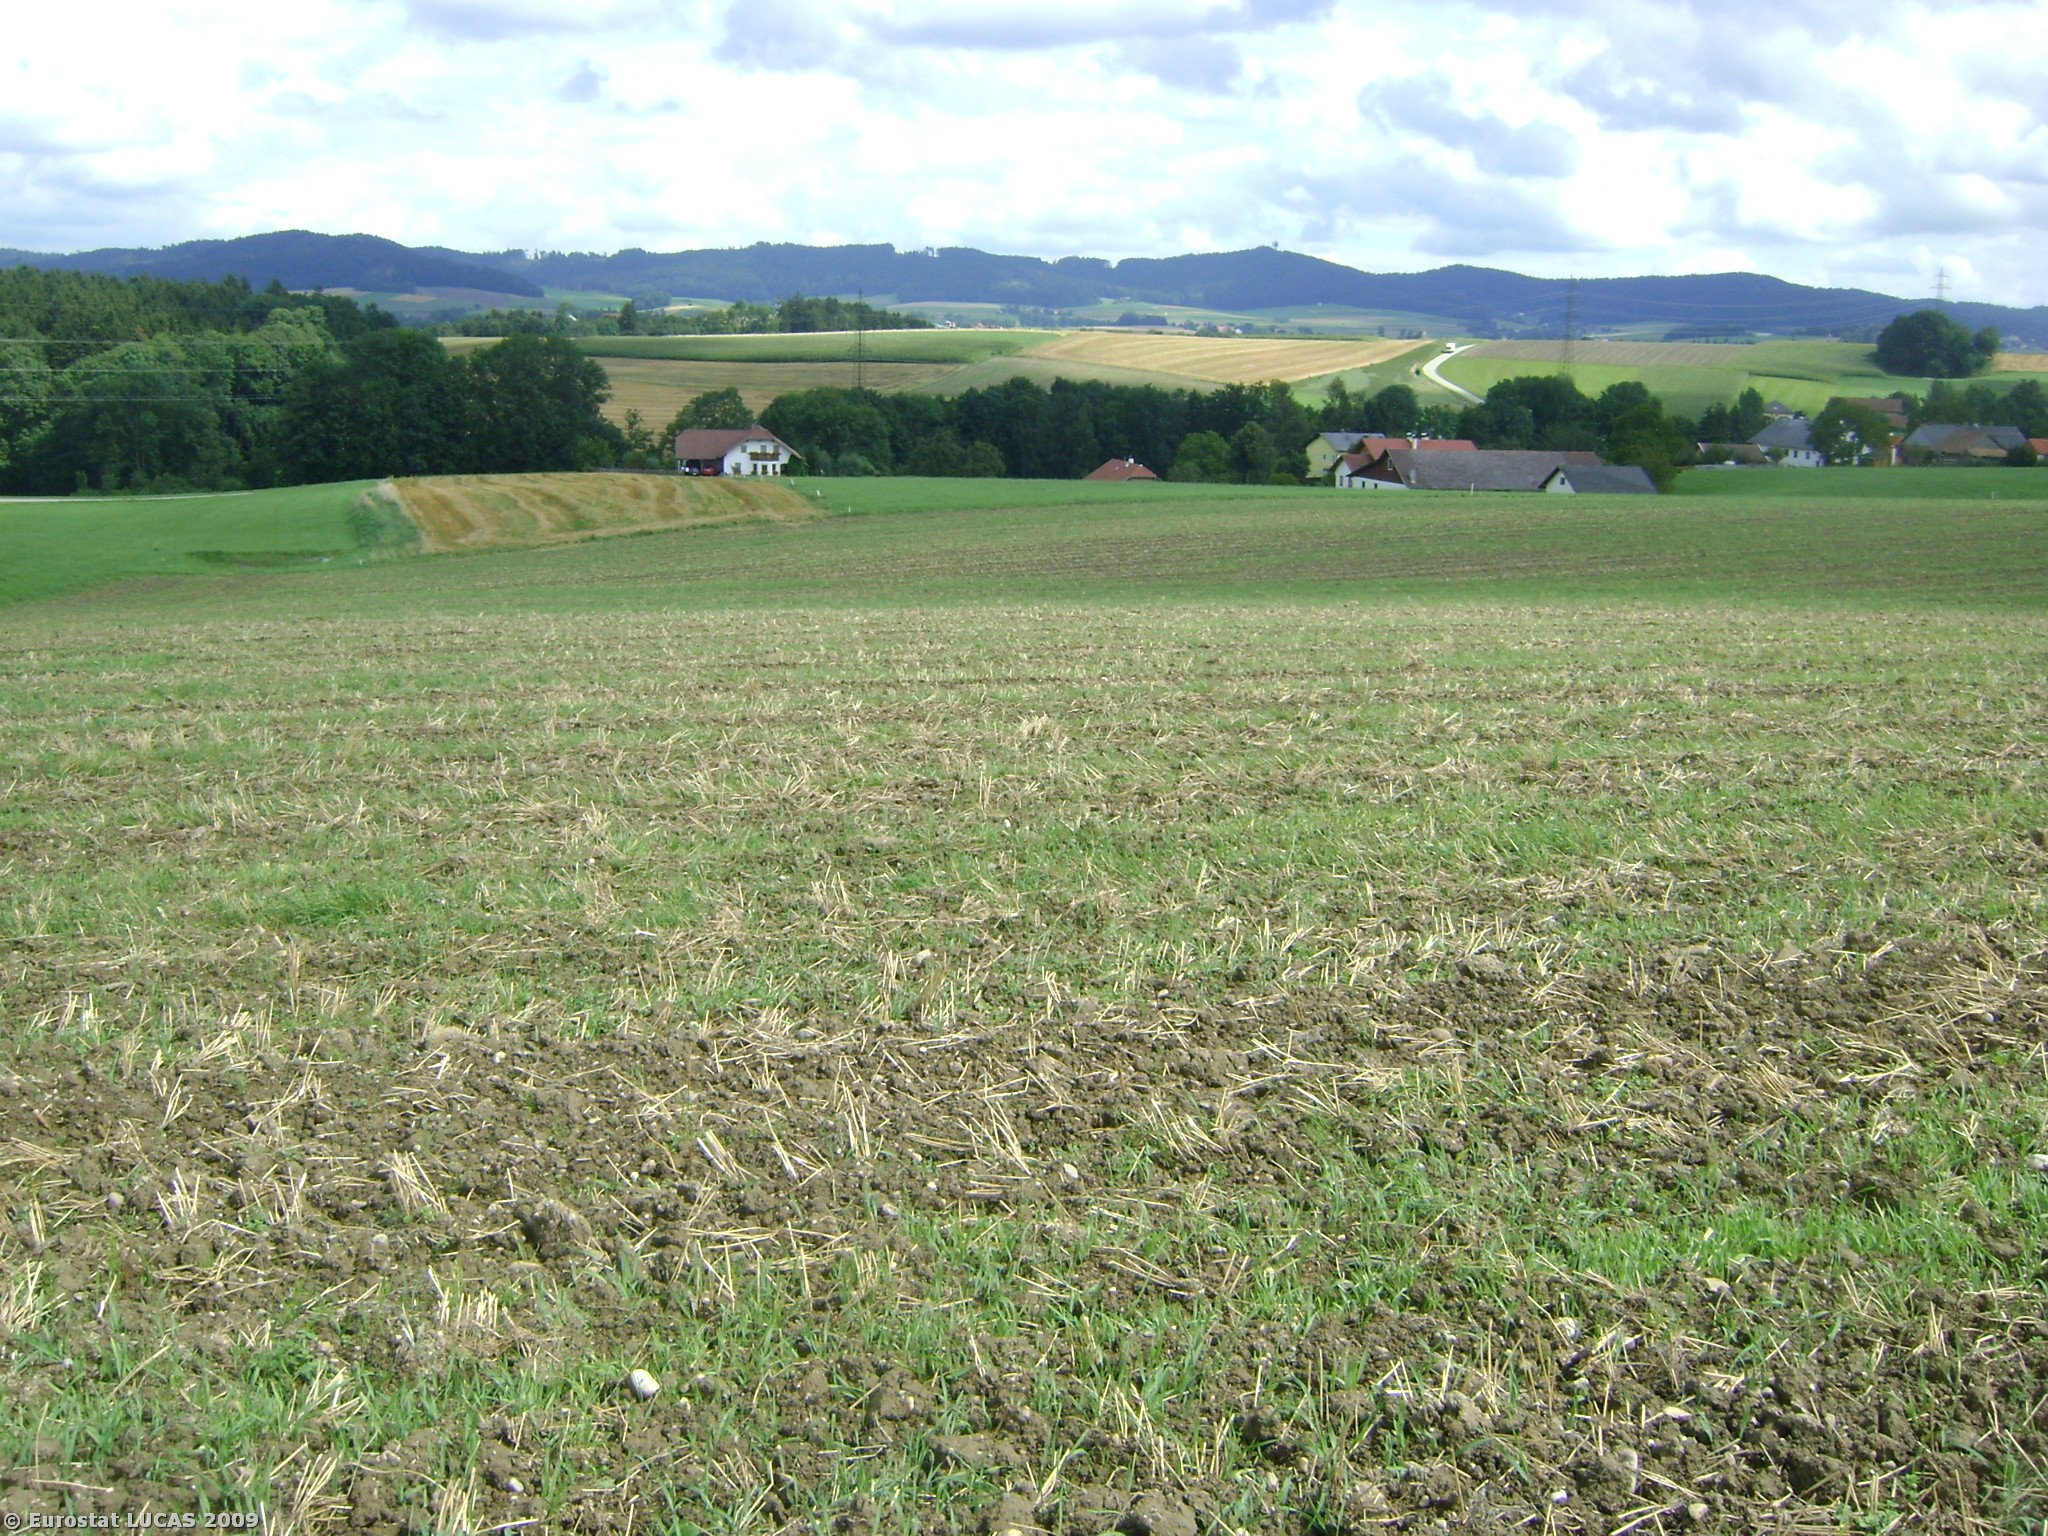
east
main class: Cropland
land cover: Triticale
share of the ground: < 10 %
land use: Agriculture (excluding fallow land and kitchen gardens)
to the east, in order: Triticale; Grassland without tree/shrub cover; Barley
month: August
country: AT
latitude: 48.1669
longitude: 13.5355
